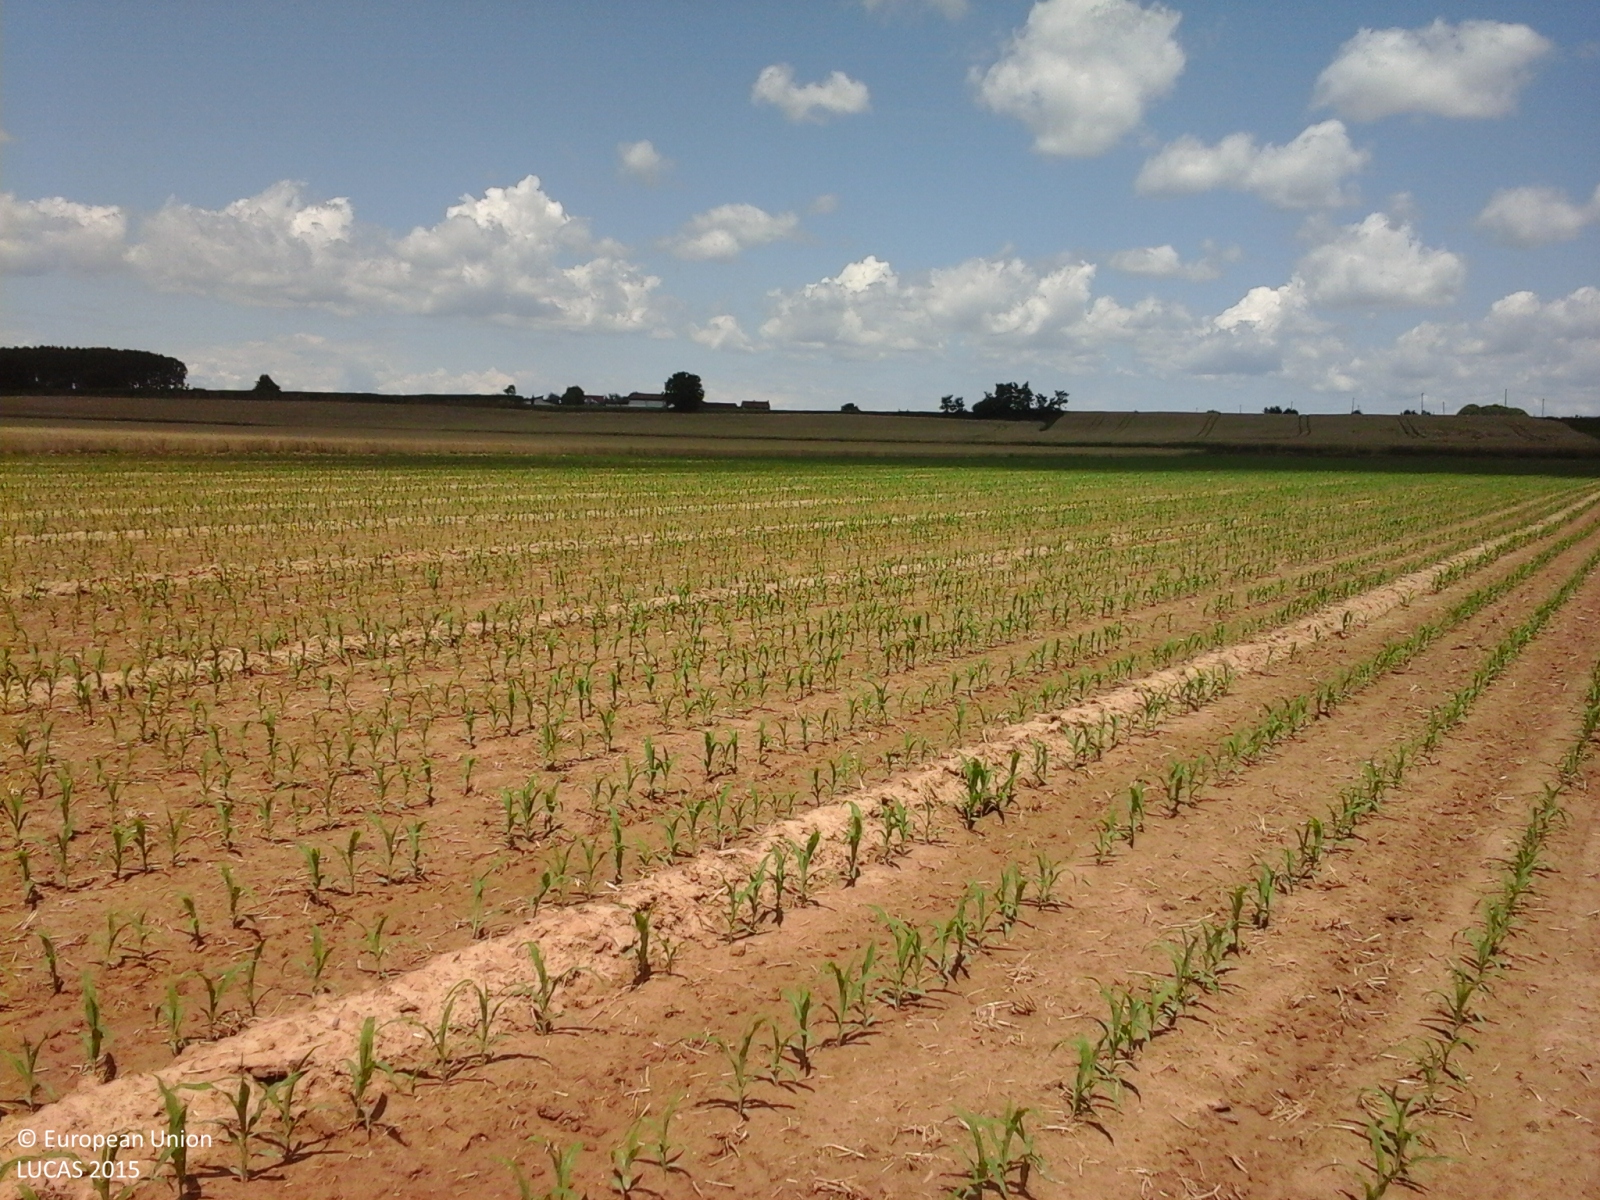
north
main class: Cropland
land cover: Maize
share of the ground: < 10 %
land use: Agriculture (excluding fallow land and kitchen gardens)
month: June
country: IT
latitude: 44.8867
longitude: 7.8137
